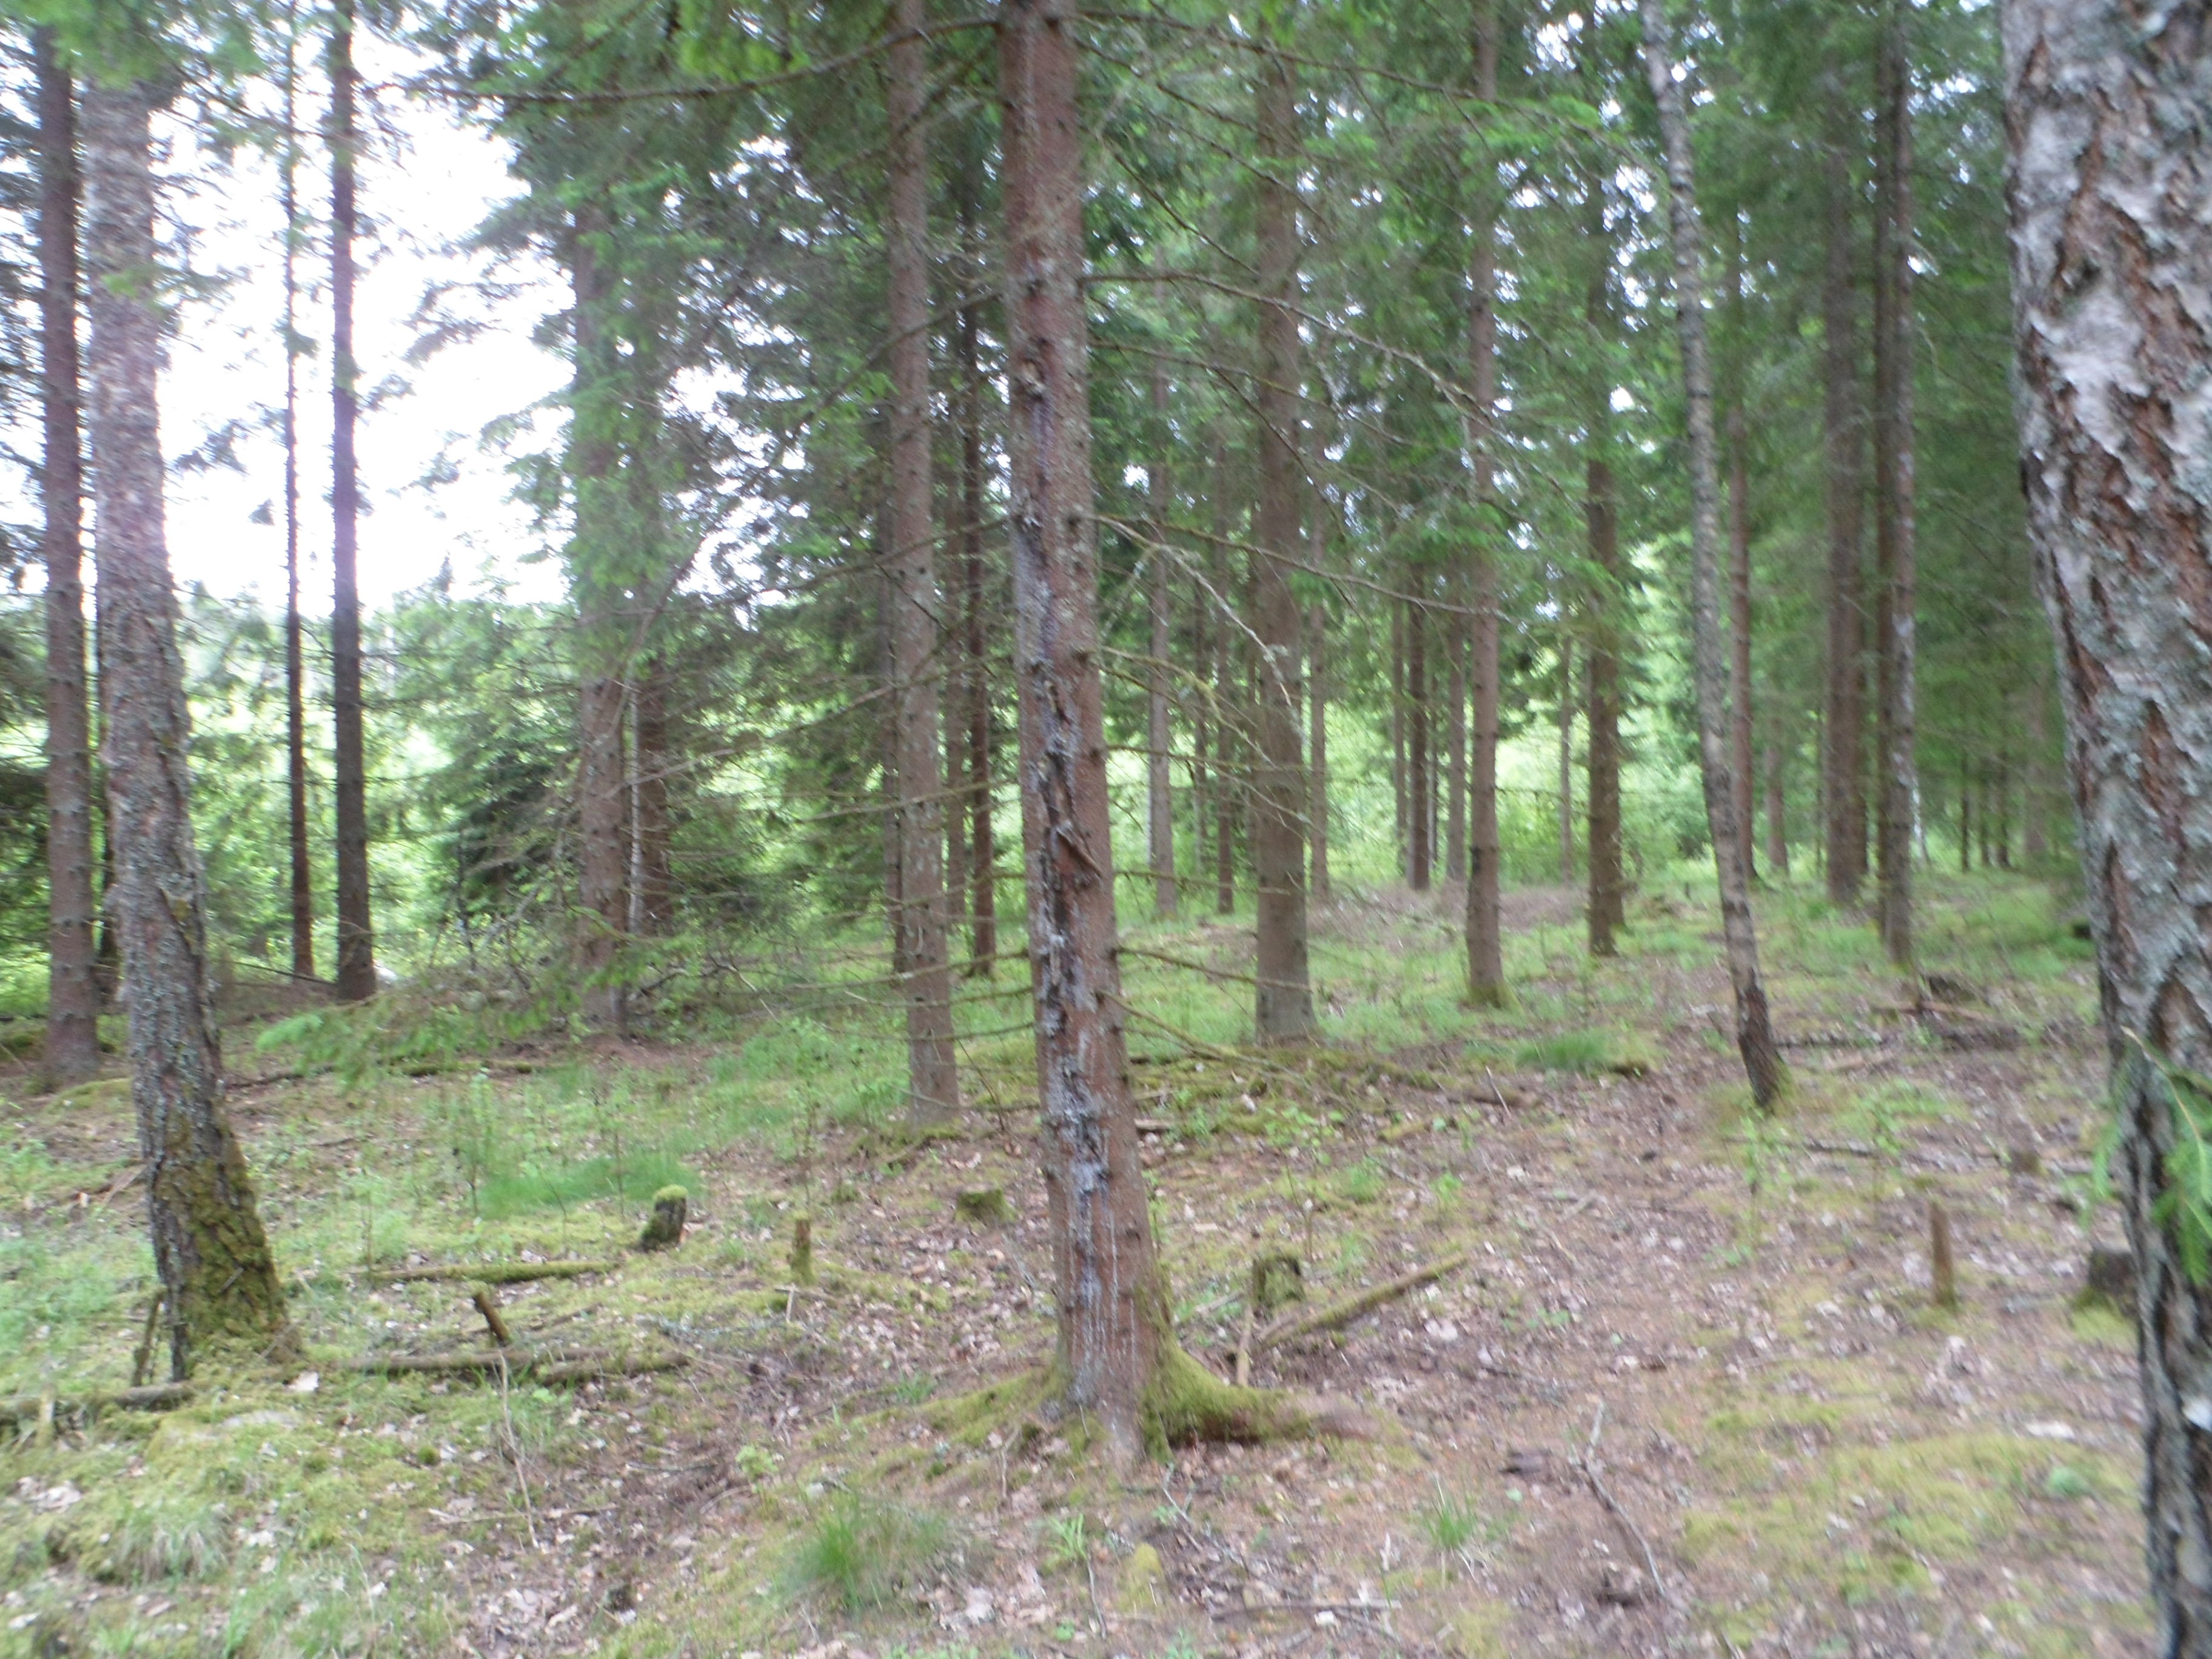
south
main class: Woodland
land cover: Spruce dominated mixed woodland
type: boreal forest
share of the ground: 50 - 75 %
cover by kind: coniferous forest trees 35 %, broadleaved forest trees 20 %, lichens and mosses 20 %, herbaceous plants 10 %, unconsolidated bare surface 10 %, shrubs 5 %
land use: Forestry
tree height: > 5 m
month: June
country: SE
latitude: 56.8078
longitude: 14.5993
